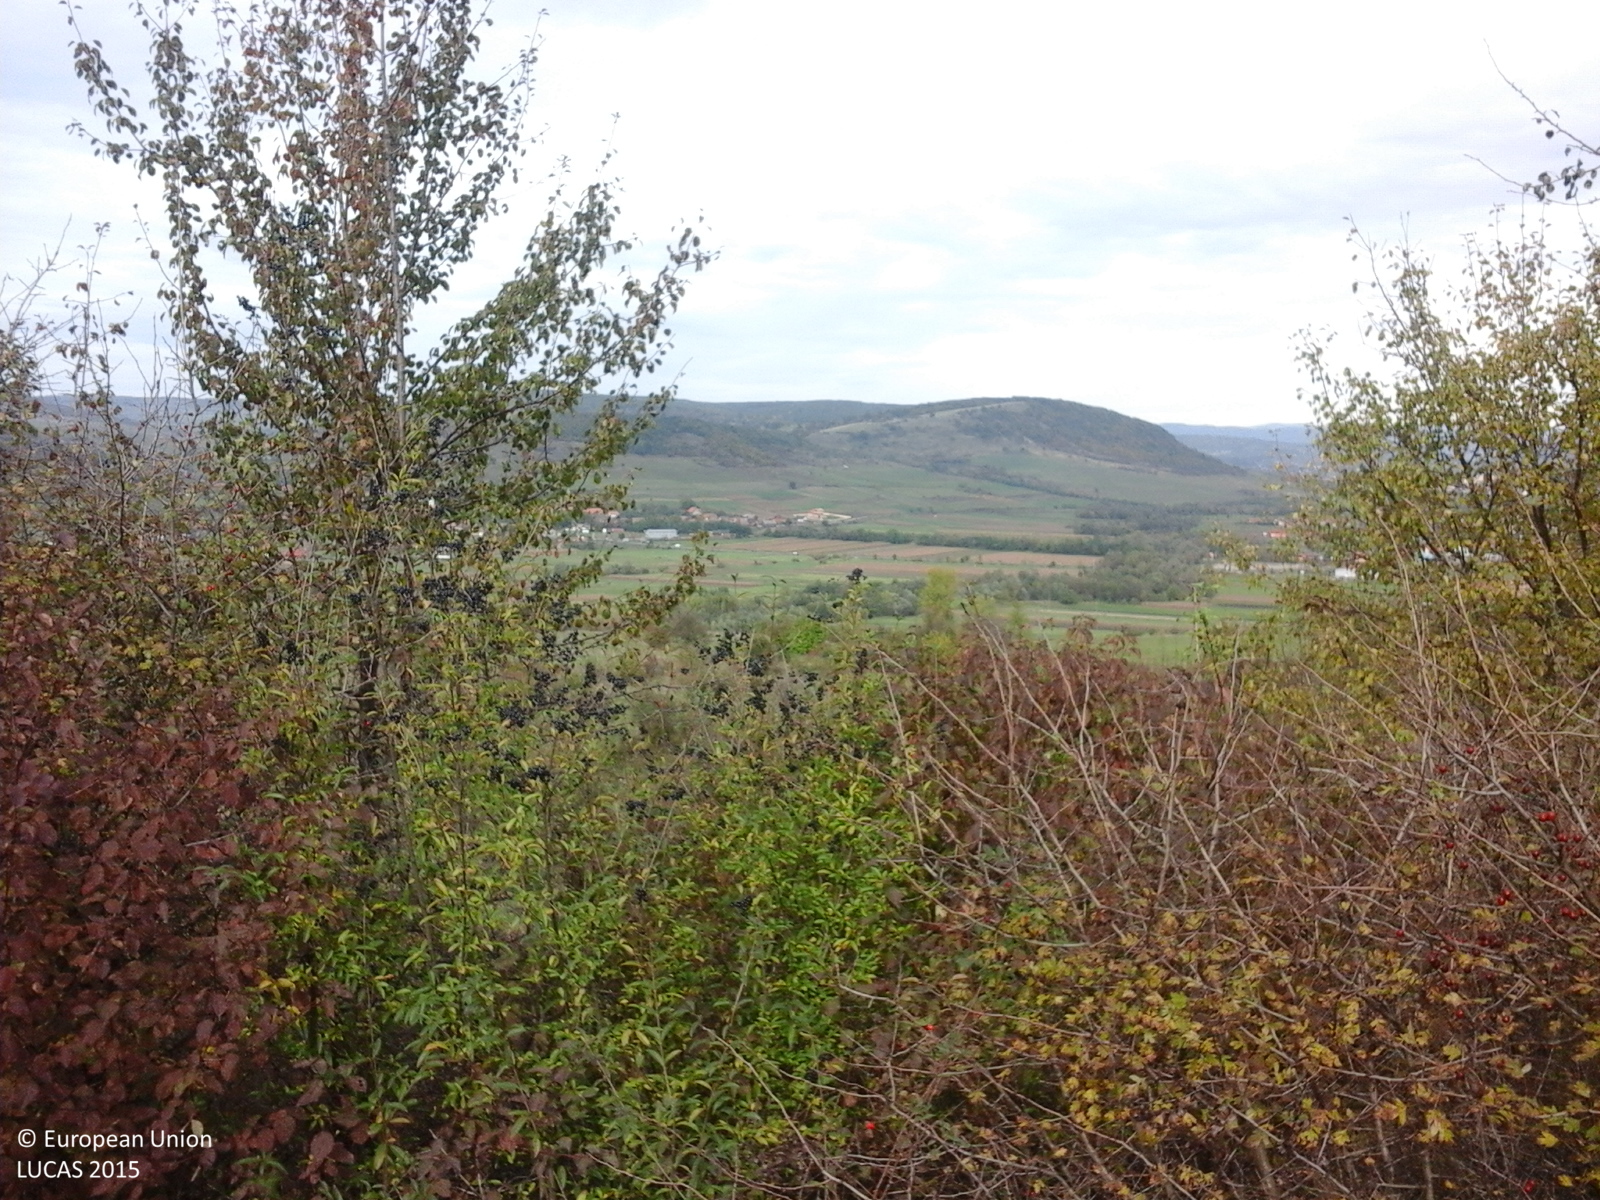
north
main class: Shrubland
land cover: Shrubland with sparse tree cover
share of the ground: > 75 %
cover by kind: herbaceous plants 60 %, shrubs 35 %, broadleaved forest trees 5 %
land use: Fallow land
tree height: < 5 m
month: October
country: RO
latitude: 46.2548
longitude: 25.2659
